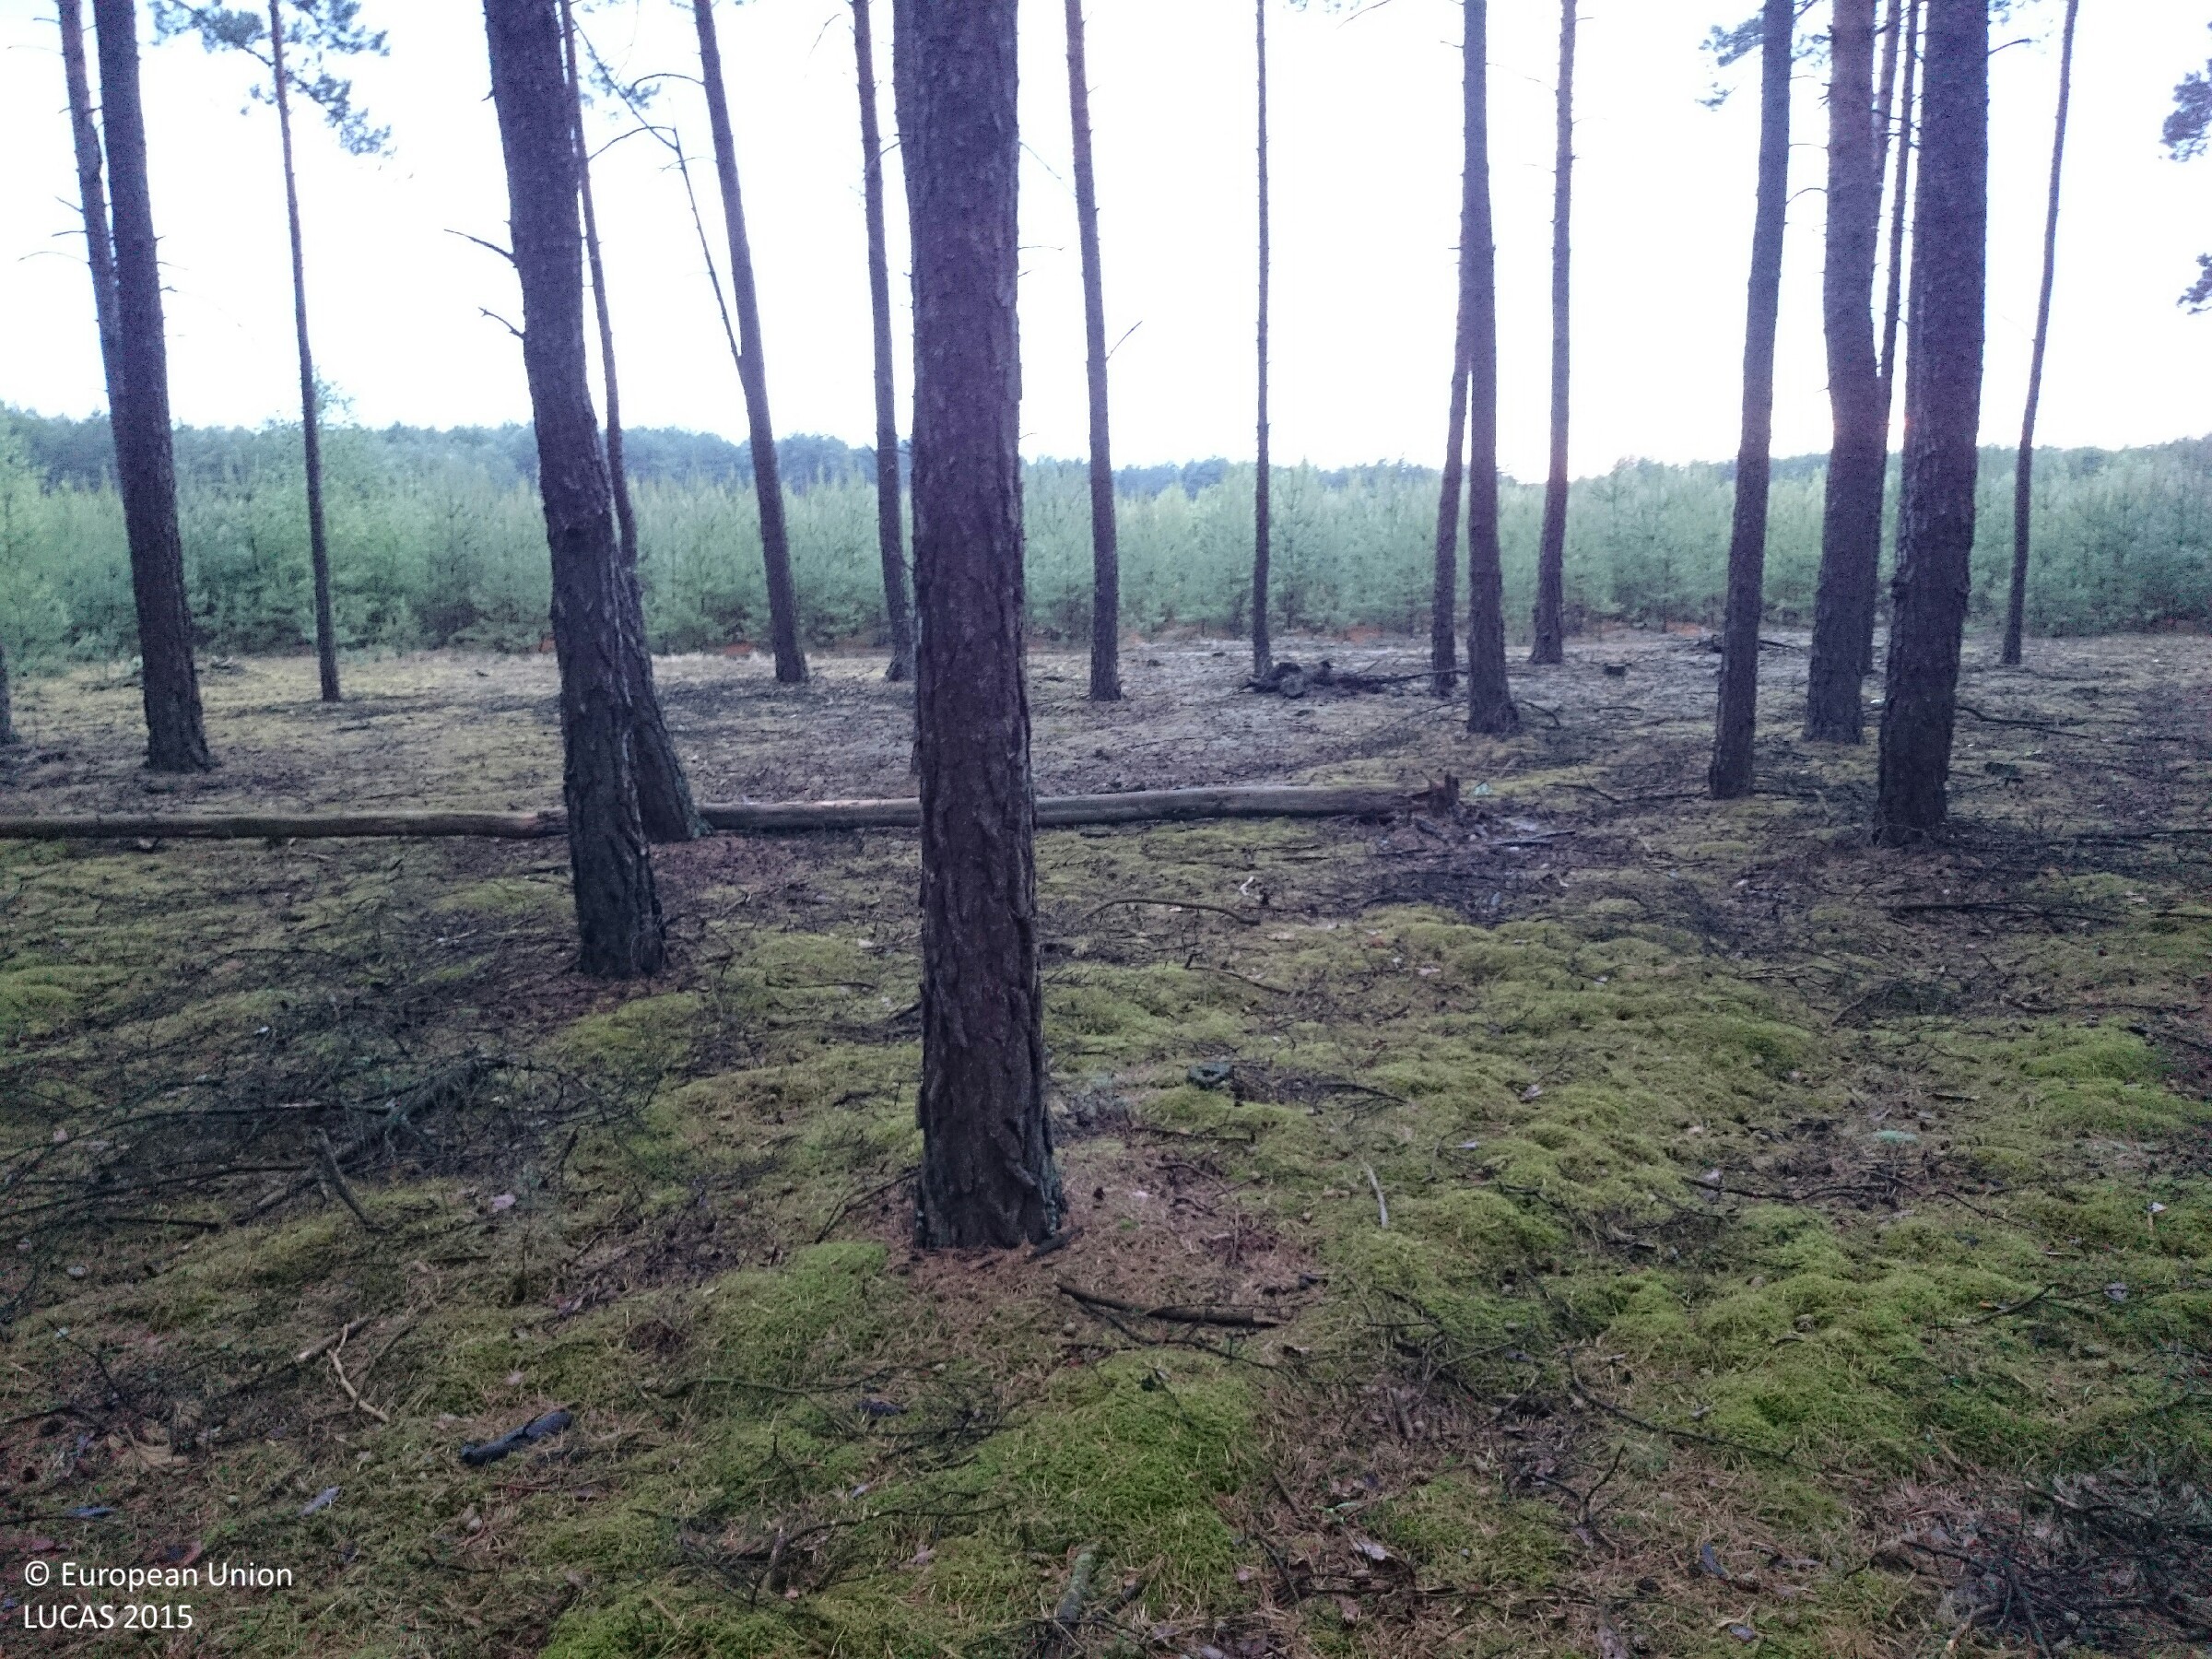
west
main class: Woodland
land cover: Pine dominated coniferous woodland
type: hemiboreal forest and nemoral coniferous forest and mixed broadleaved-coniferous forest
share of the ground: > 75 %
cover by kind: coniferous forest trees 100 %
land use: Forestry
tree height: > 5 m
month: June
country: PL
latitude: 52.7283
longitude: 15.6757
